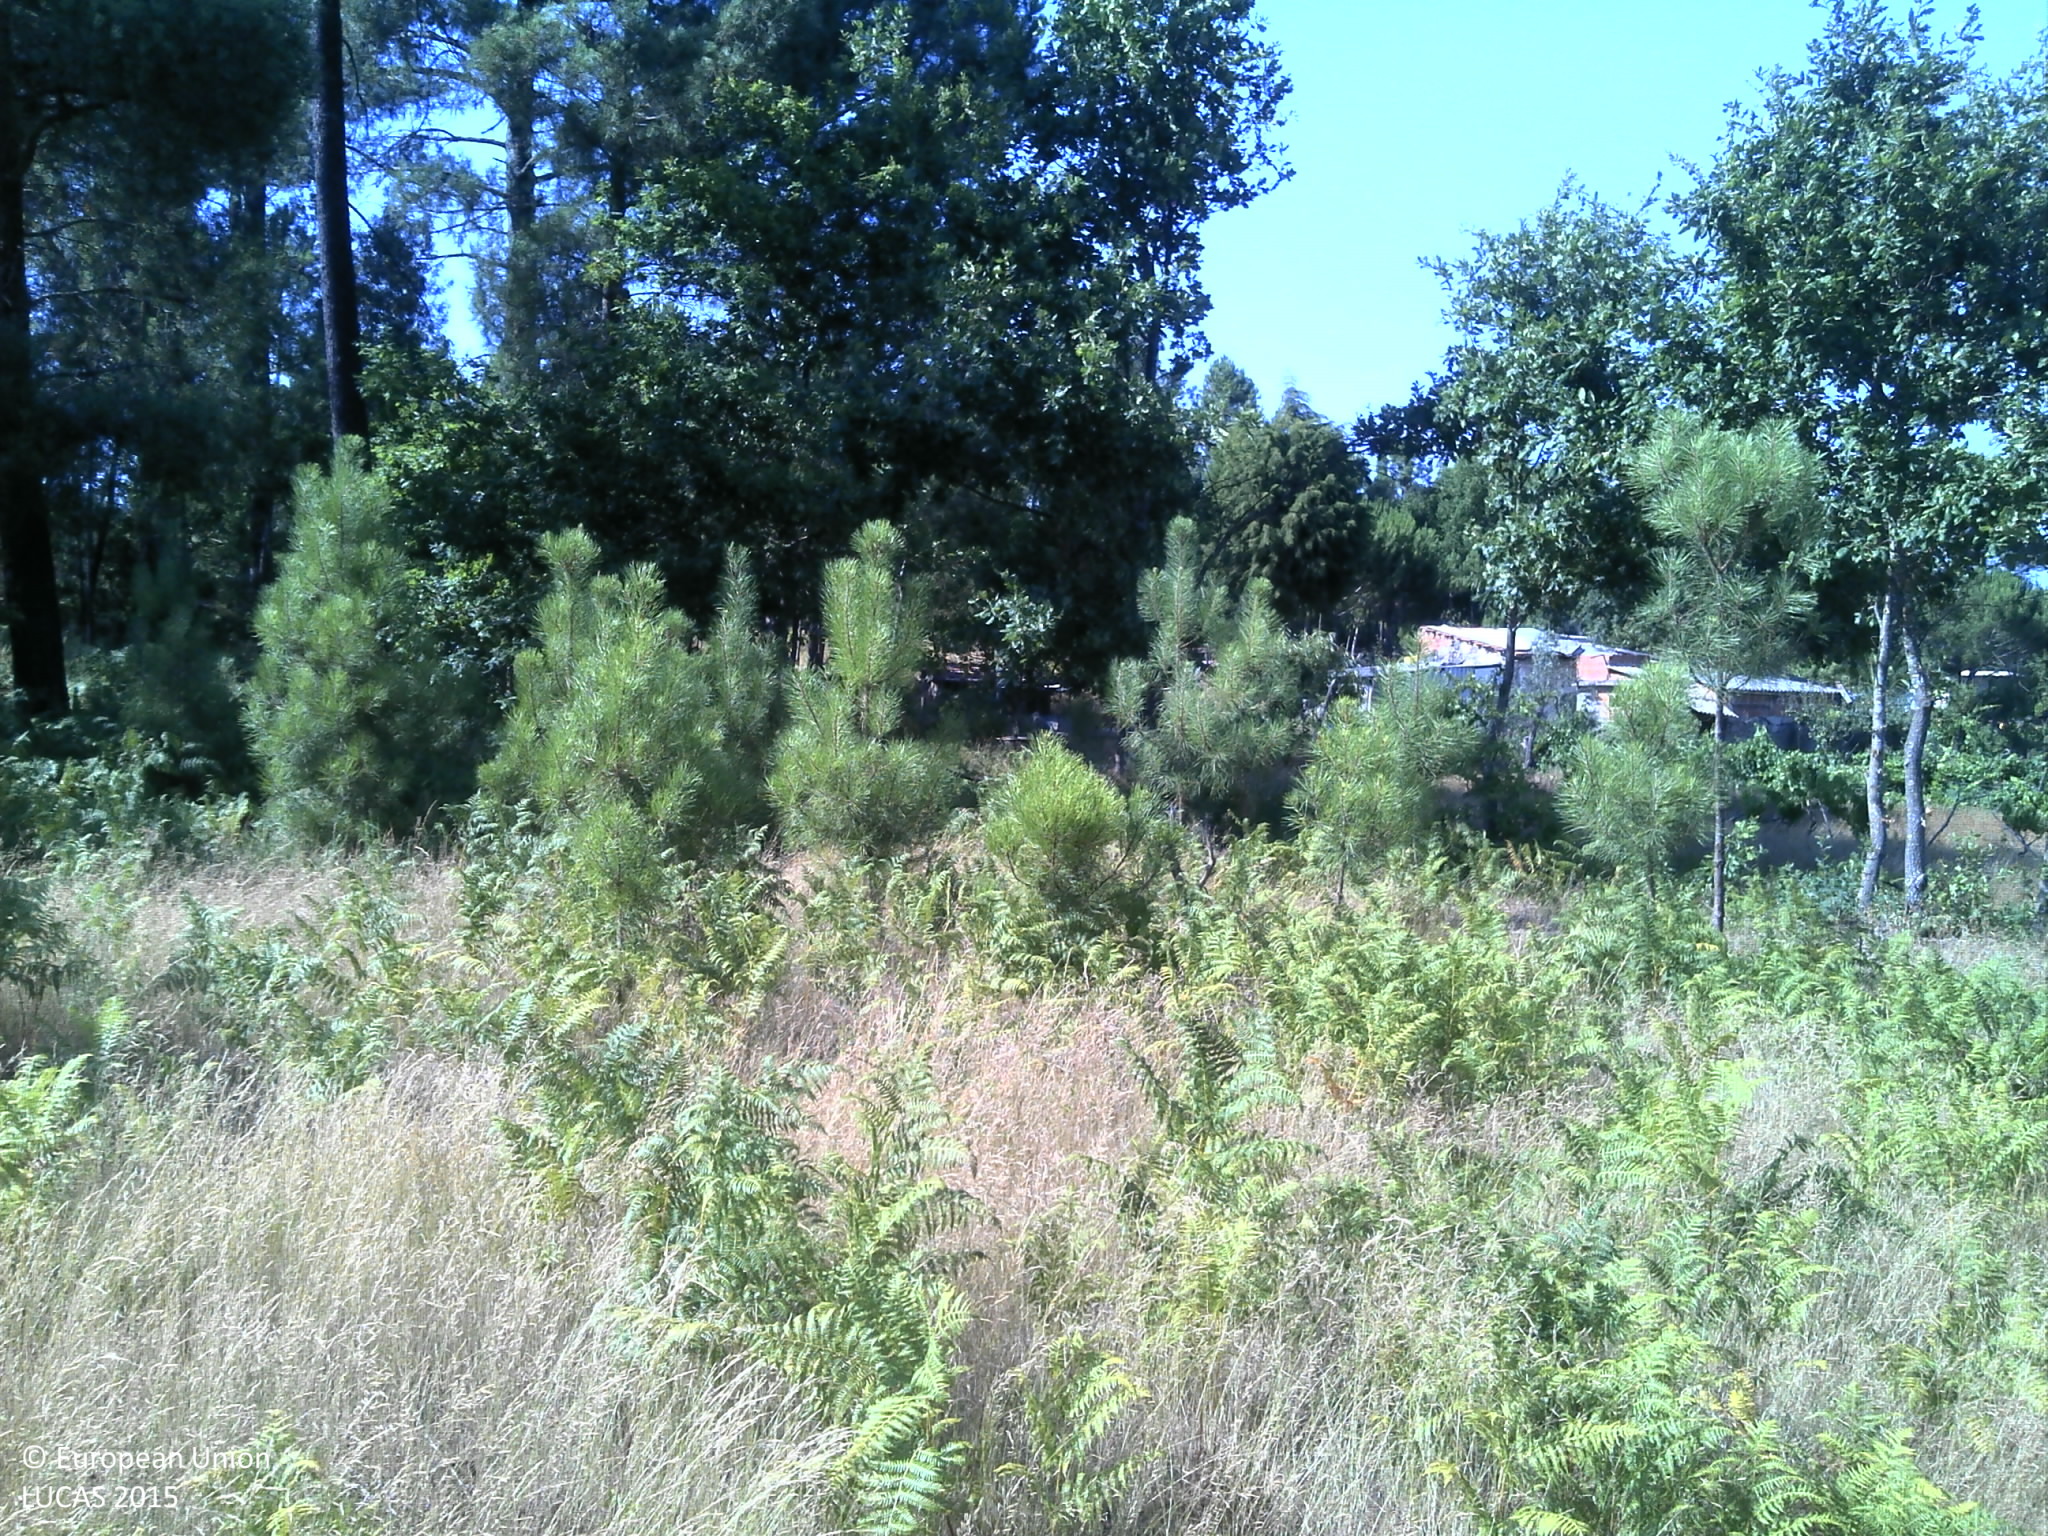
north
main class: Grassland
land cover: Grassland without tree/shrub cover
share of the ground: > 75 %
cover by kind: herbaceous plants 80 %, unconsolidated bare surface 20 %
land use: Agriculture (excluding fallow land and kitchen gardens)
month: July
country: PT
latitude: 40.4465
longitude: -7.9367
